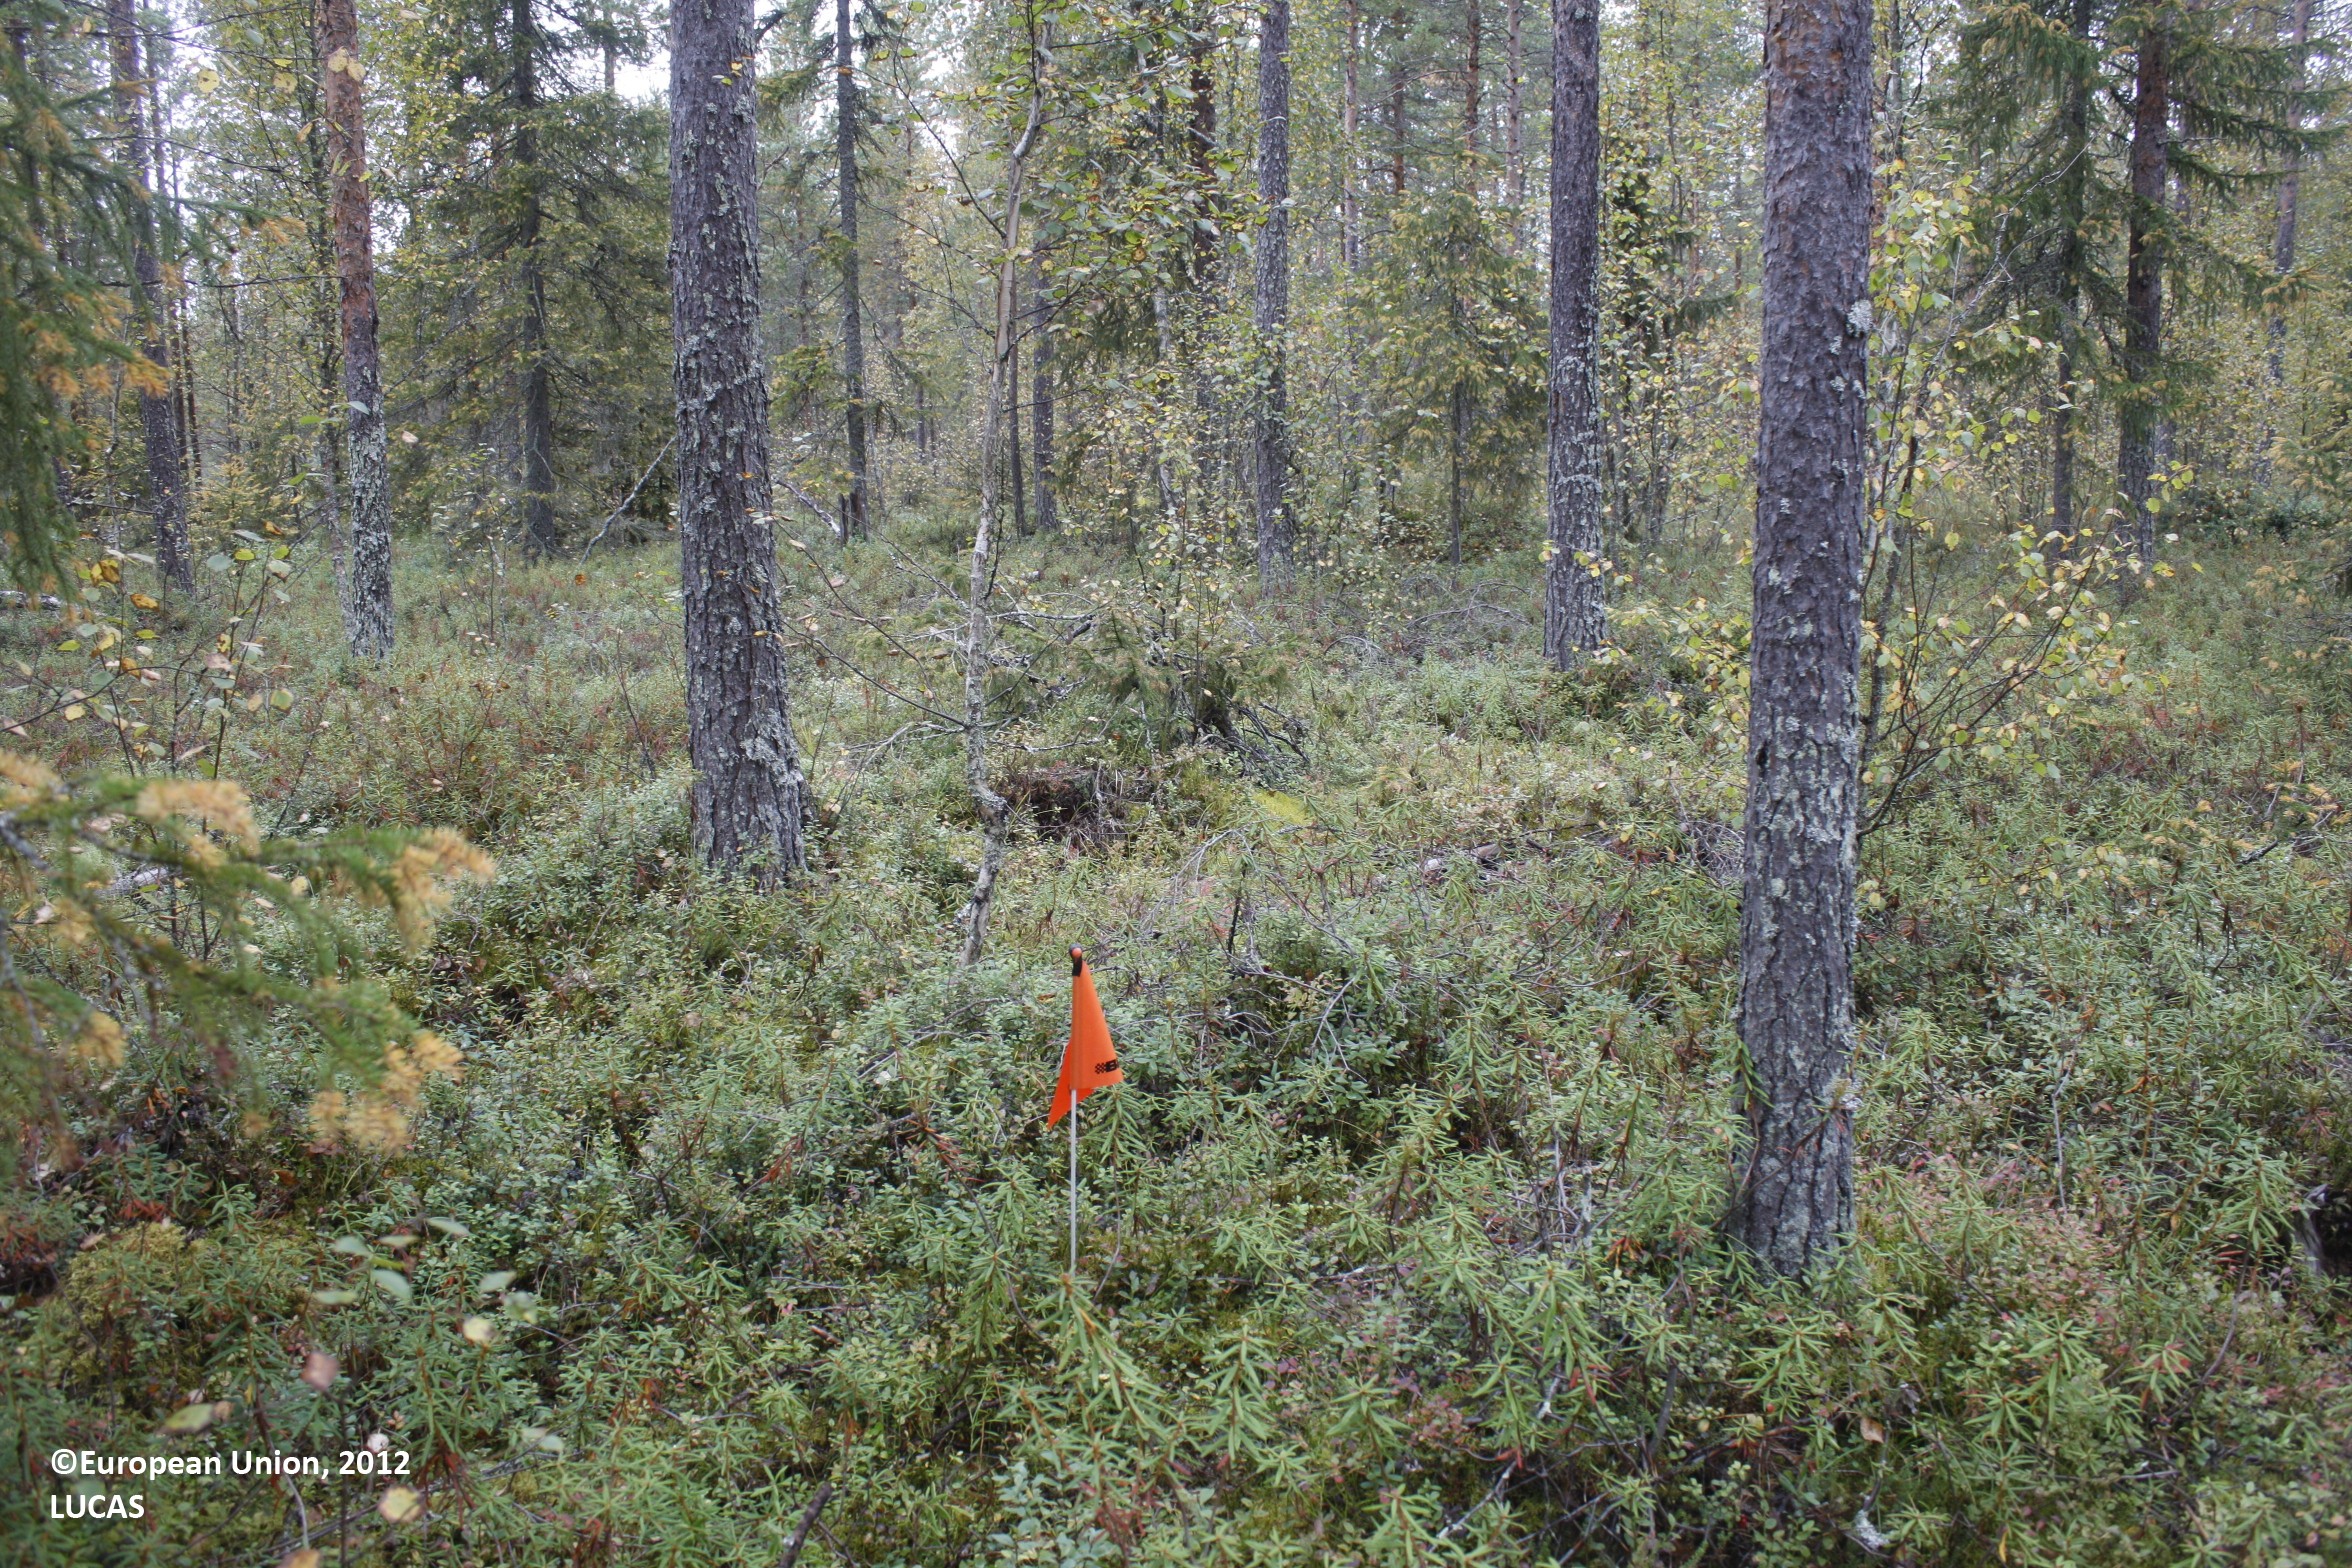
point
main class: Woodland
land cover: Pine dominated mixed woodland
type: boreal forest
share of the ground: 25 - 50 %
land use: Forestry
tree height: > 5 m
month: September
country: FI
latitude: 65.1269
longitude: 26.7984
